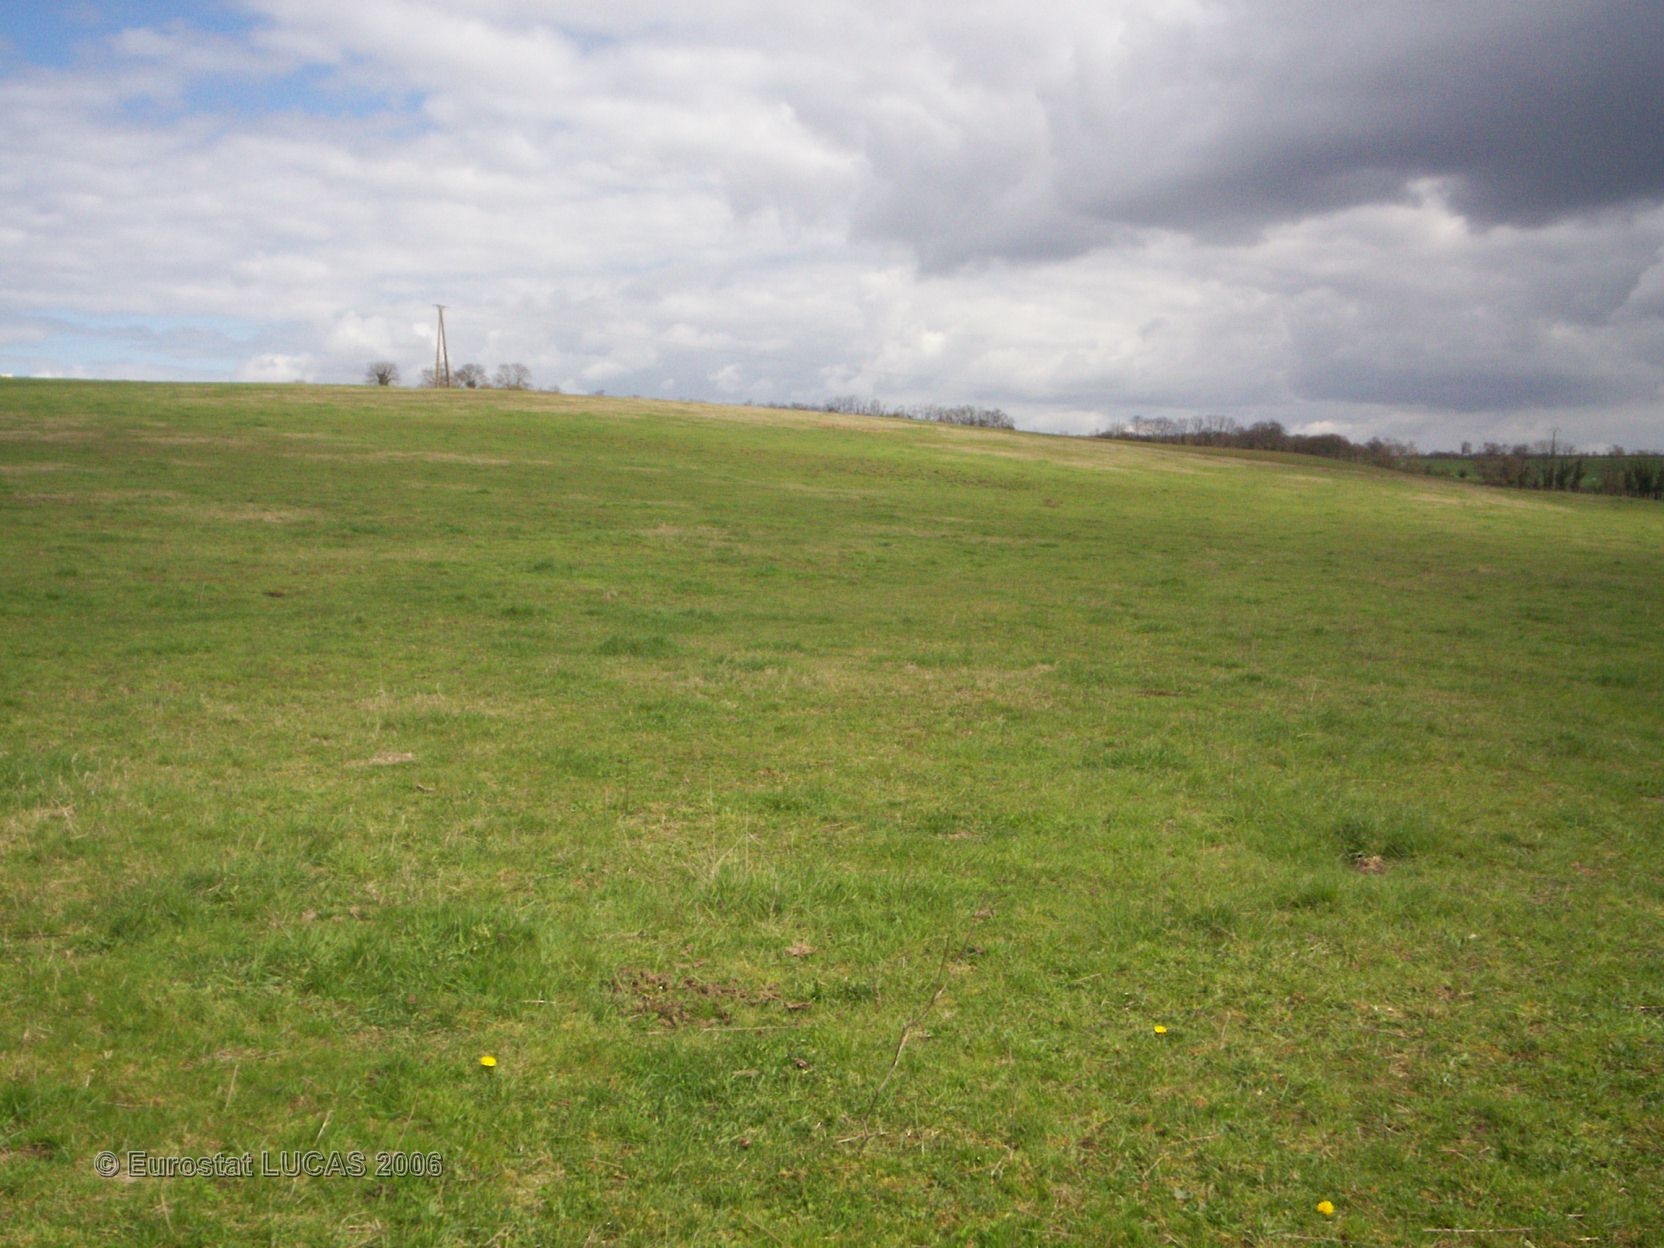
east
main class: Grassland
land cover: Grassland without tree/shrub cover
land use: Agriculture (excluding fallow land and kitchen gardens)
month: April
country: FR
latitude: 46.9219
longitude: 3.0756
